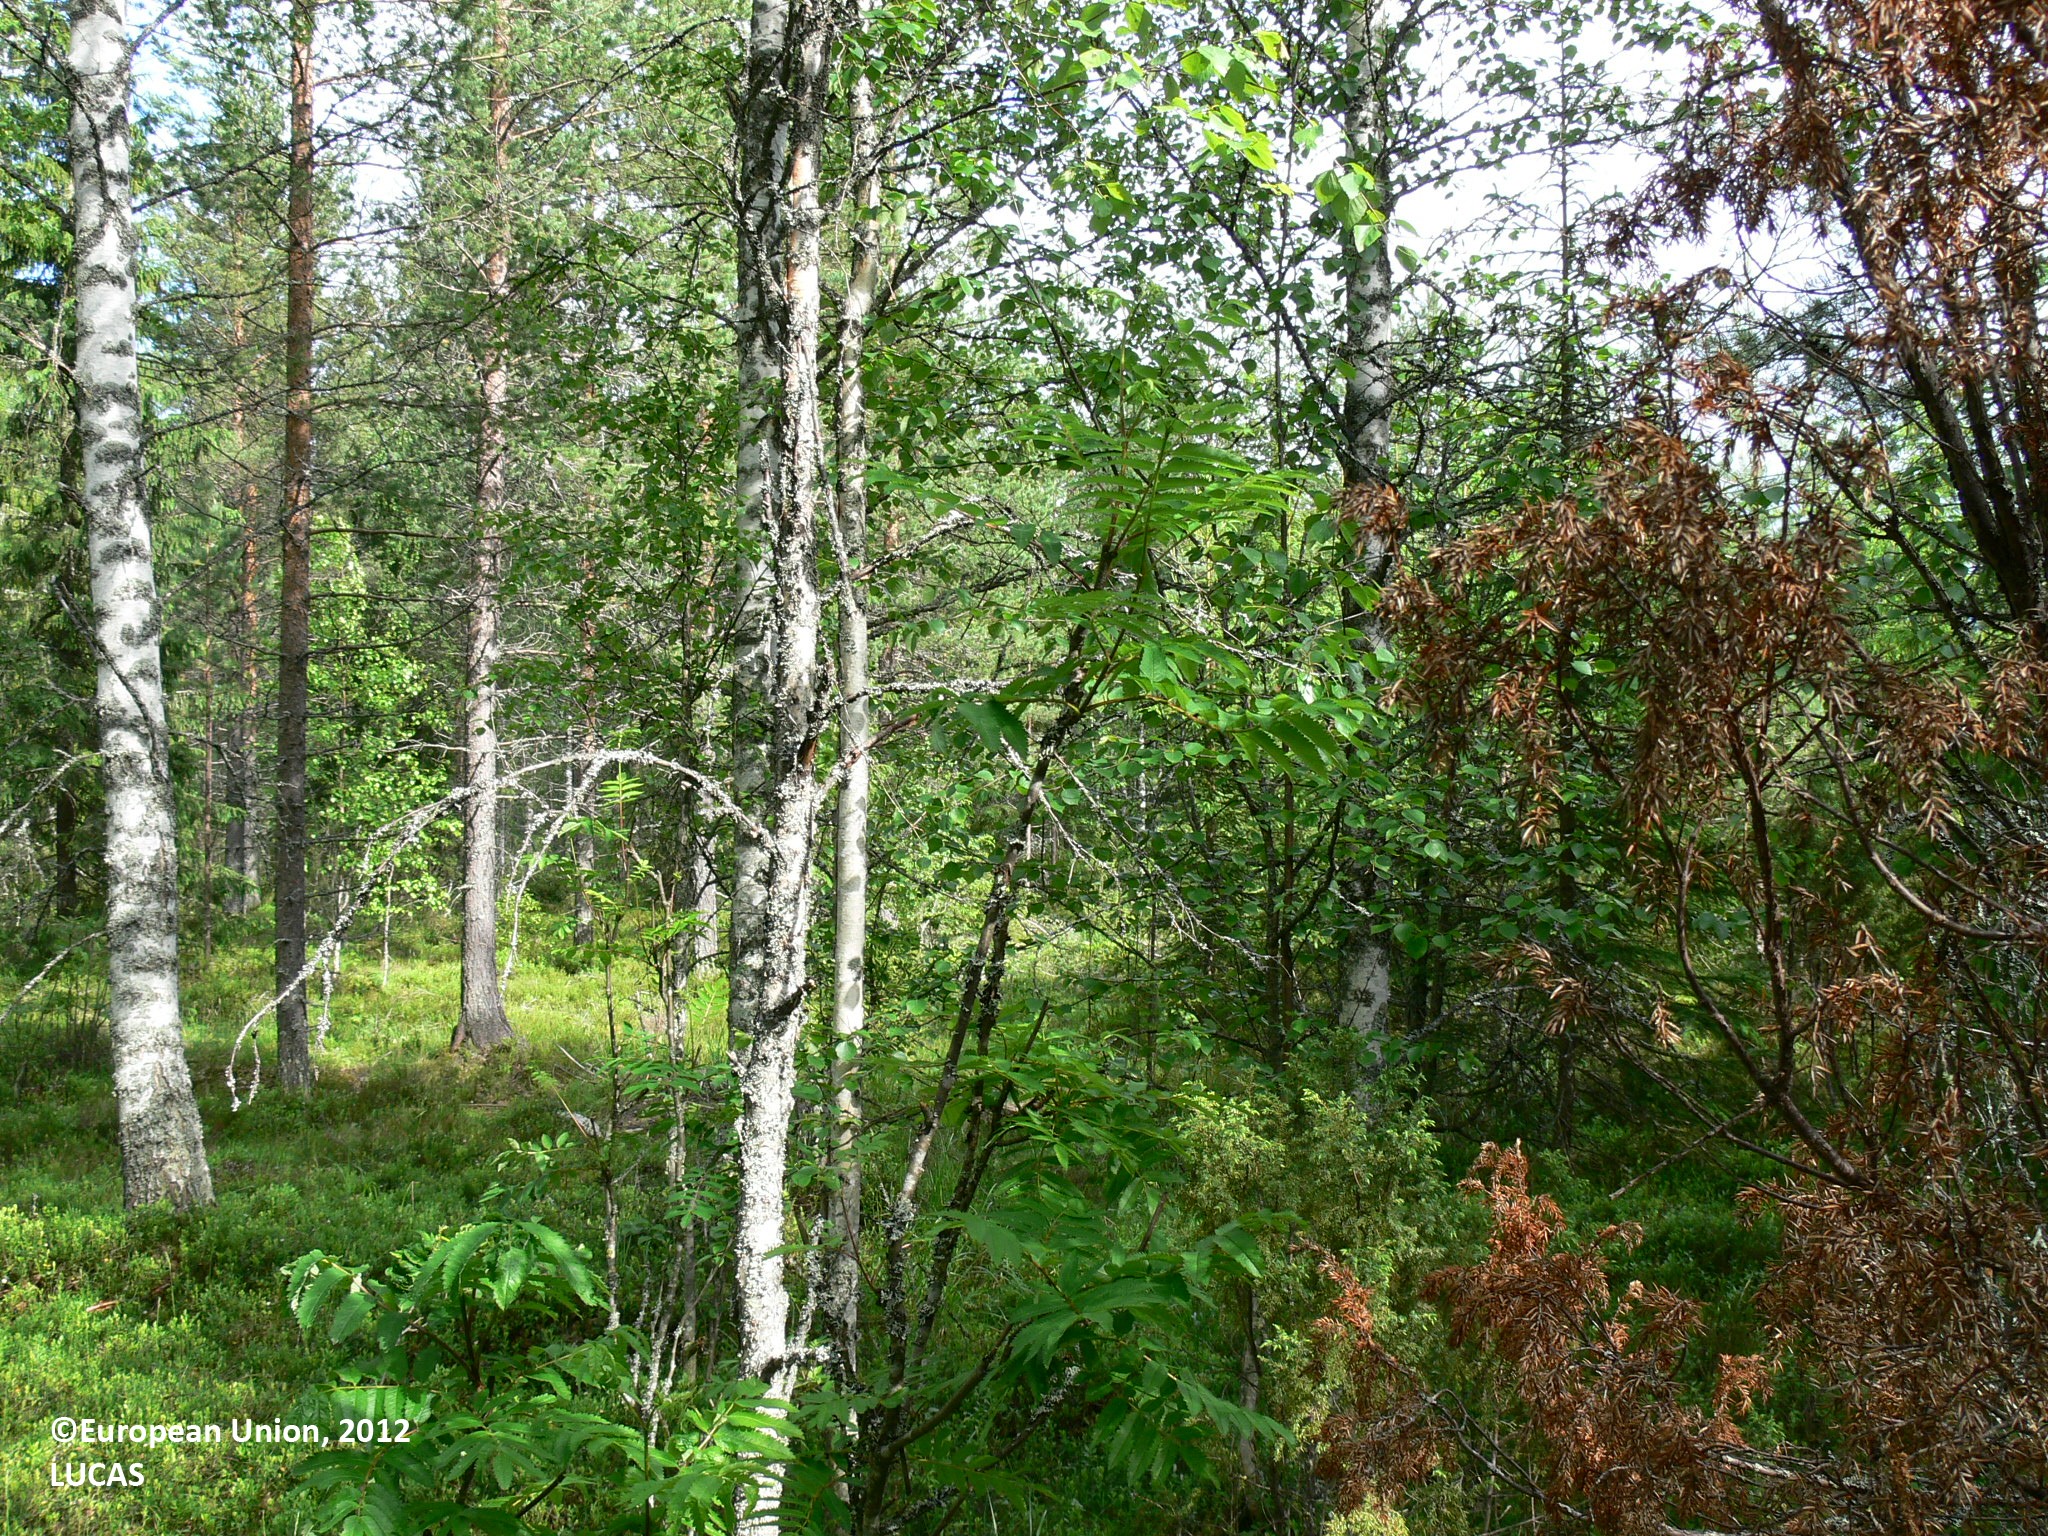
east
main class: Woodland
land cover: Other mixed woodland
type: boreal forest
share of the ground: 50 - 75 %
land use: Forestry
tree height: > 5 m
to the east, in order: Other mixed woodland; Pine dominated coniferous woodland; Pine dominated mixed woodland; Pine dominated coniferous woodland
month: June
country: FI
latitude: 62.7340
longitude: 30.4908
